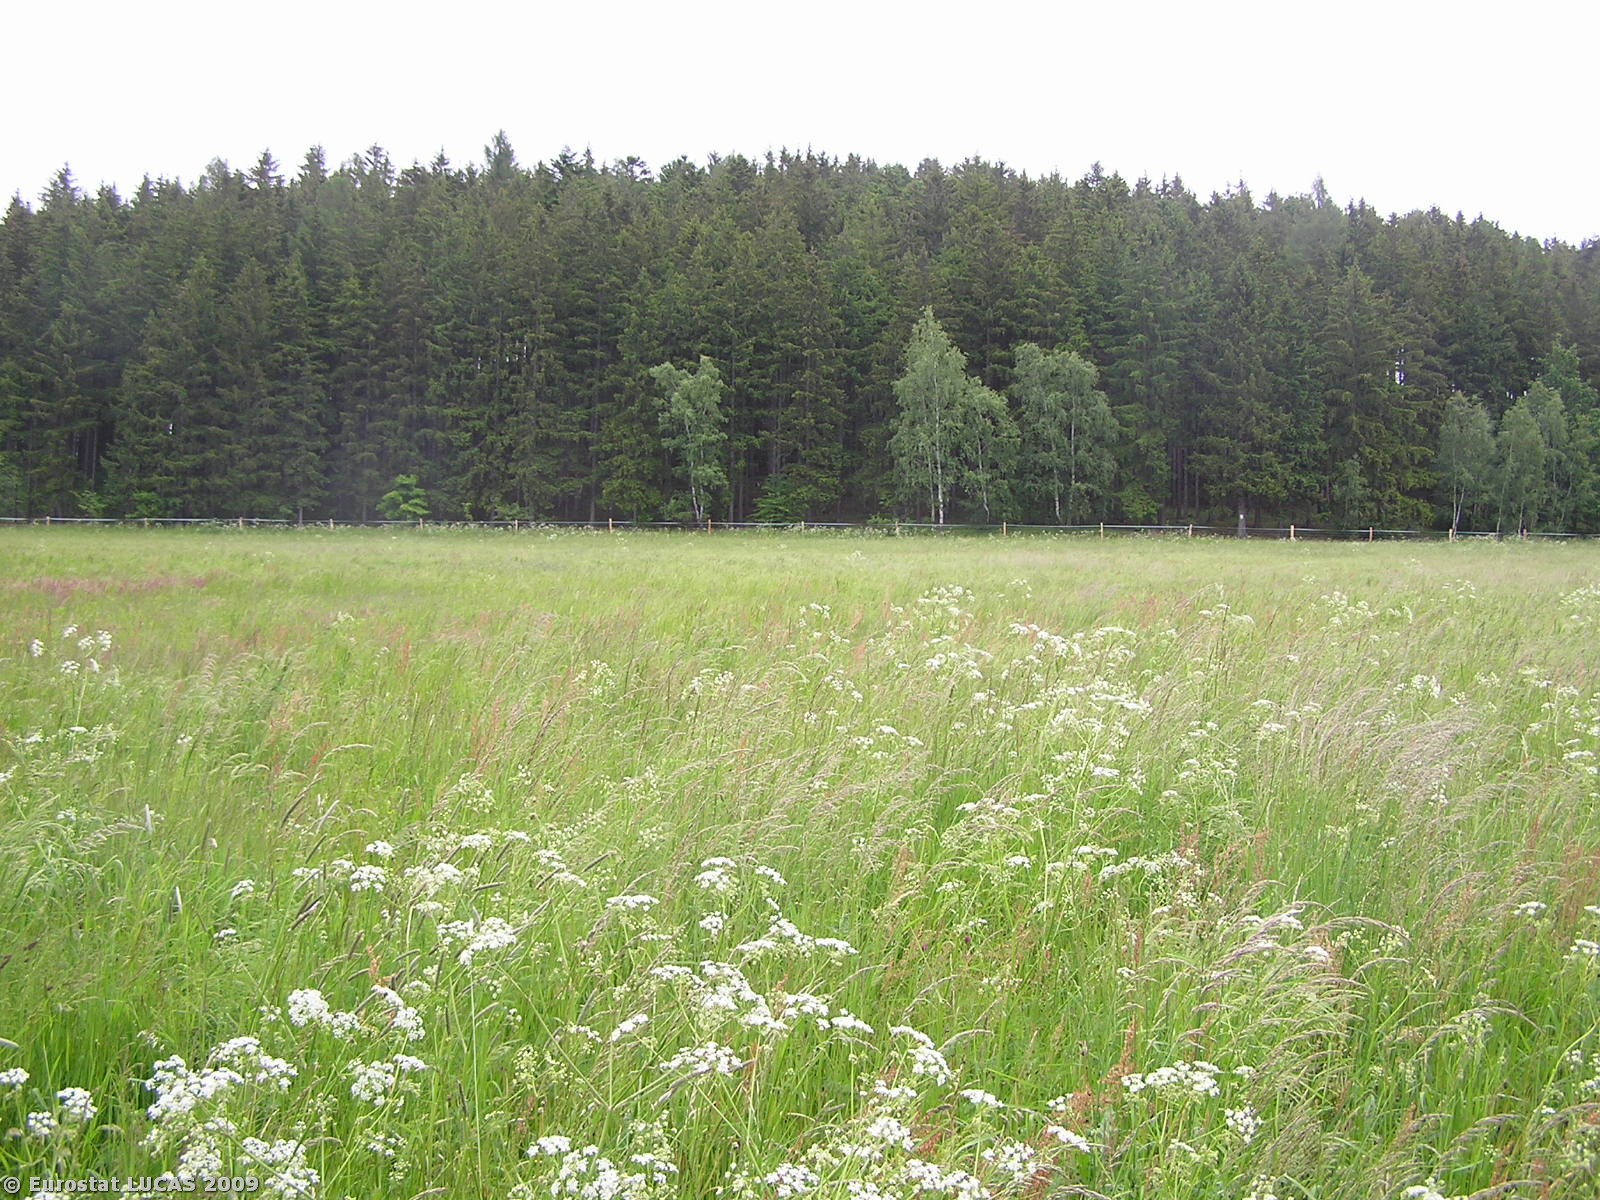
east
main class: Grassland
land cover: Grassland without tree/shrub cover
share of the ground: > 75 %
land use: Agriculture (excluding fallow land and kitchen gardens)
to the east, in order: Grassland without tree/shrub cover; Fences; Tracks; Coniferous woodland
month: June
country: CZ
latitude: 50.0644
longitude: 17.4862
